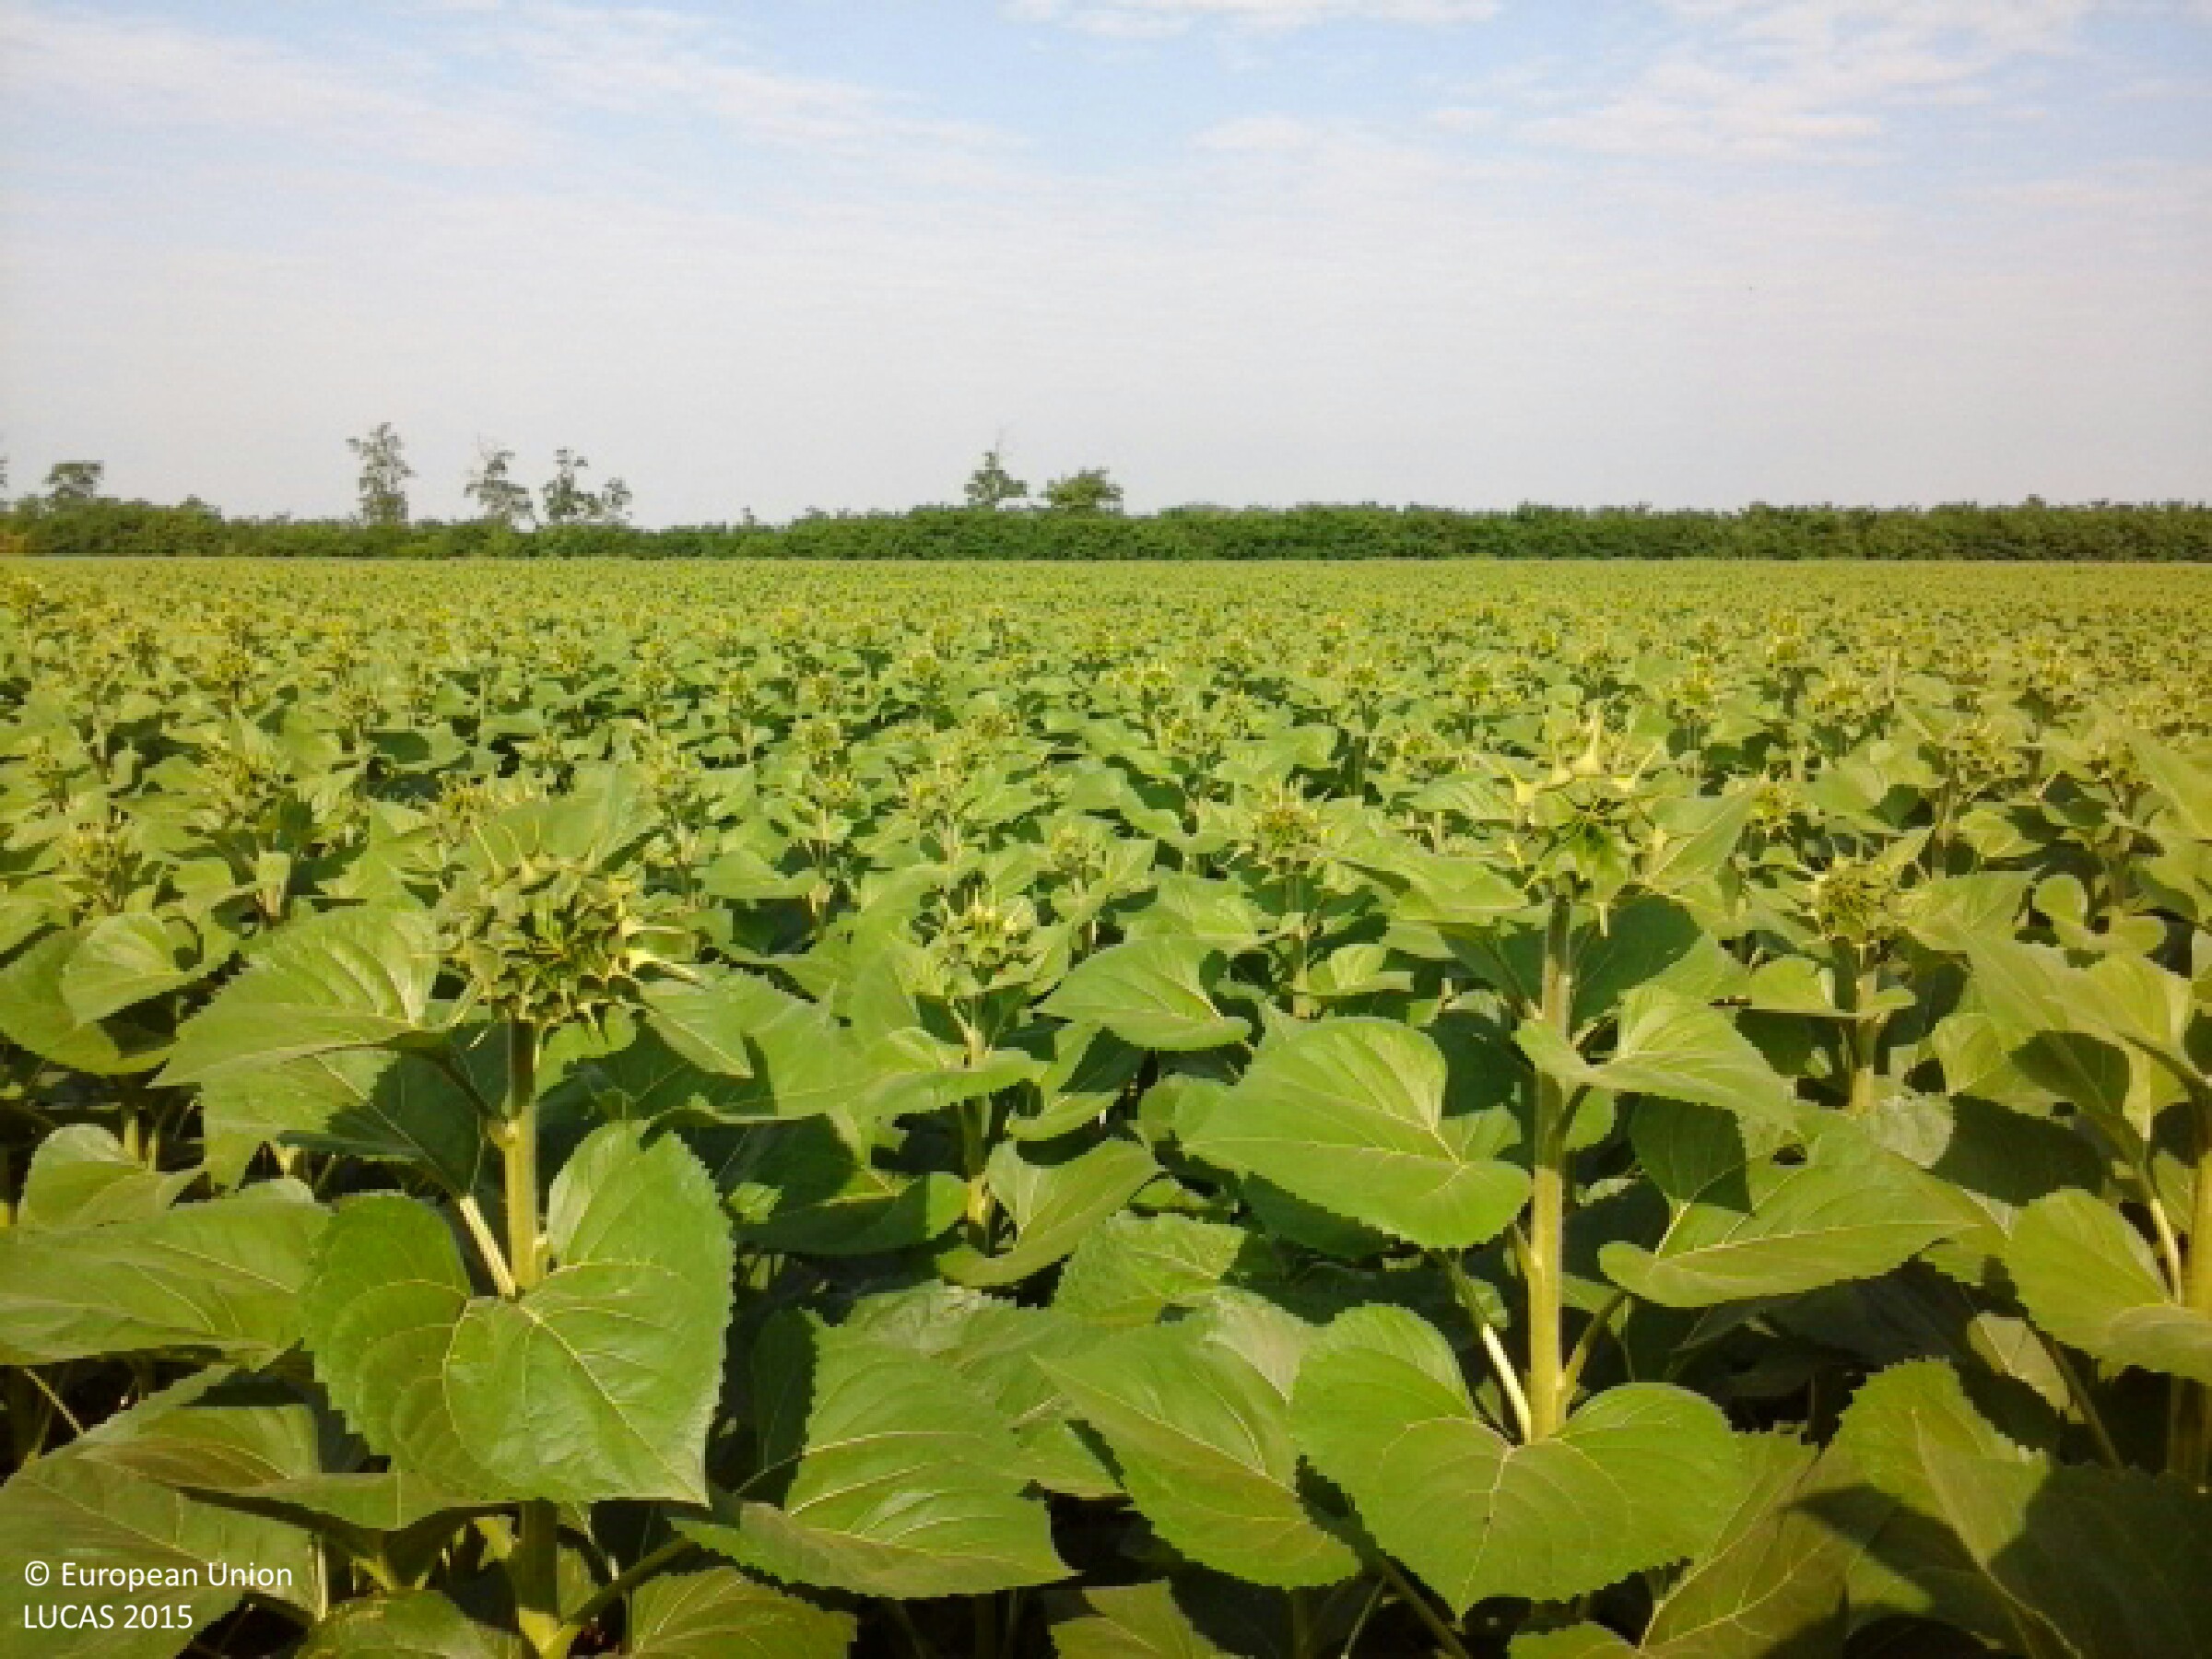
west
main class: Cropland
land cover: Sunflower
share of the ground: > 75 %
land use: Agriculture (excluding fallow land and kitchen gardens)
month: June
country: HU
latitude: 48.0334
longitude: 21.5392
